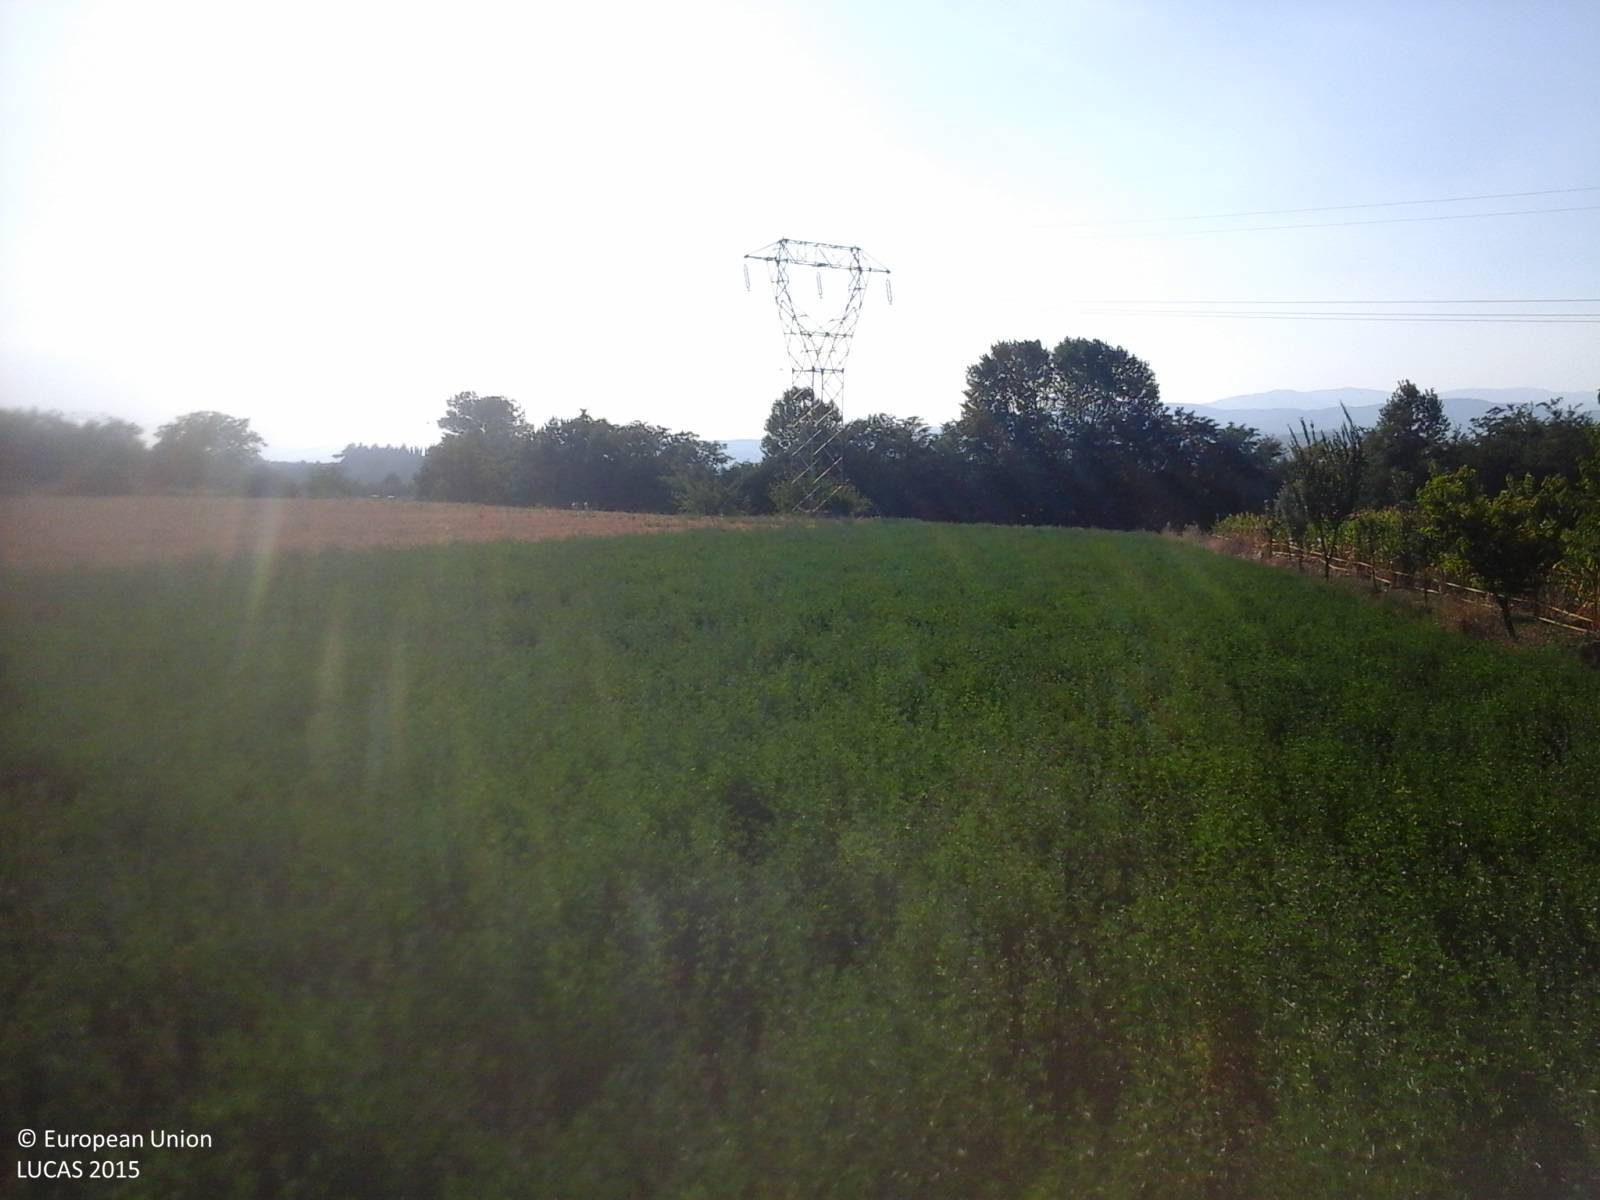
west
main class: Cropland
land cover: Lucerne
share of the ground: > 75 %
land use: Agriculture (excluding fallow land and kitchen gardens)
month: August
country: IT
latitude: 43.5213
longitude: 11.8878
